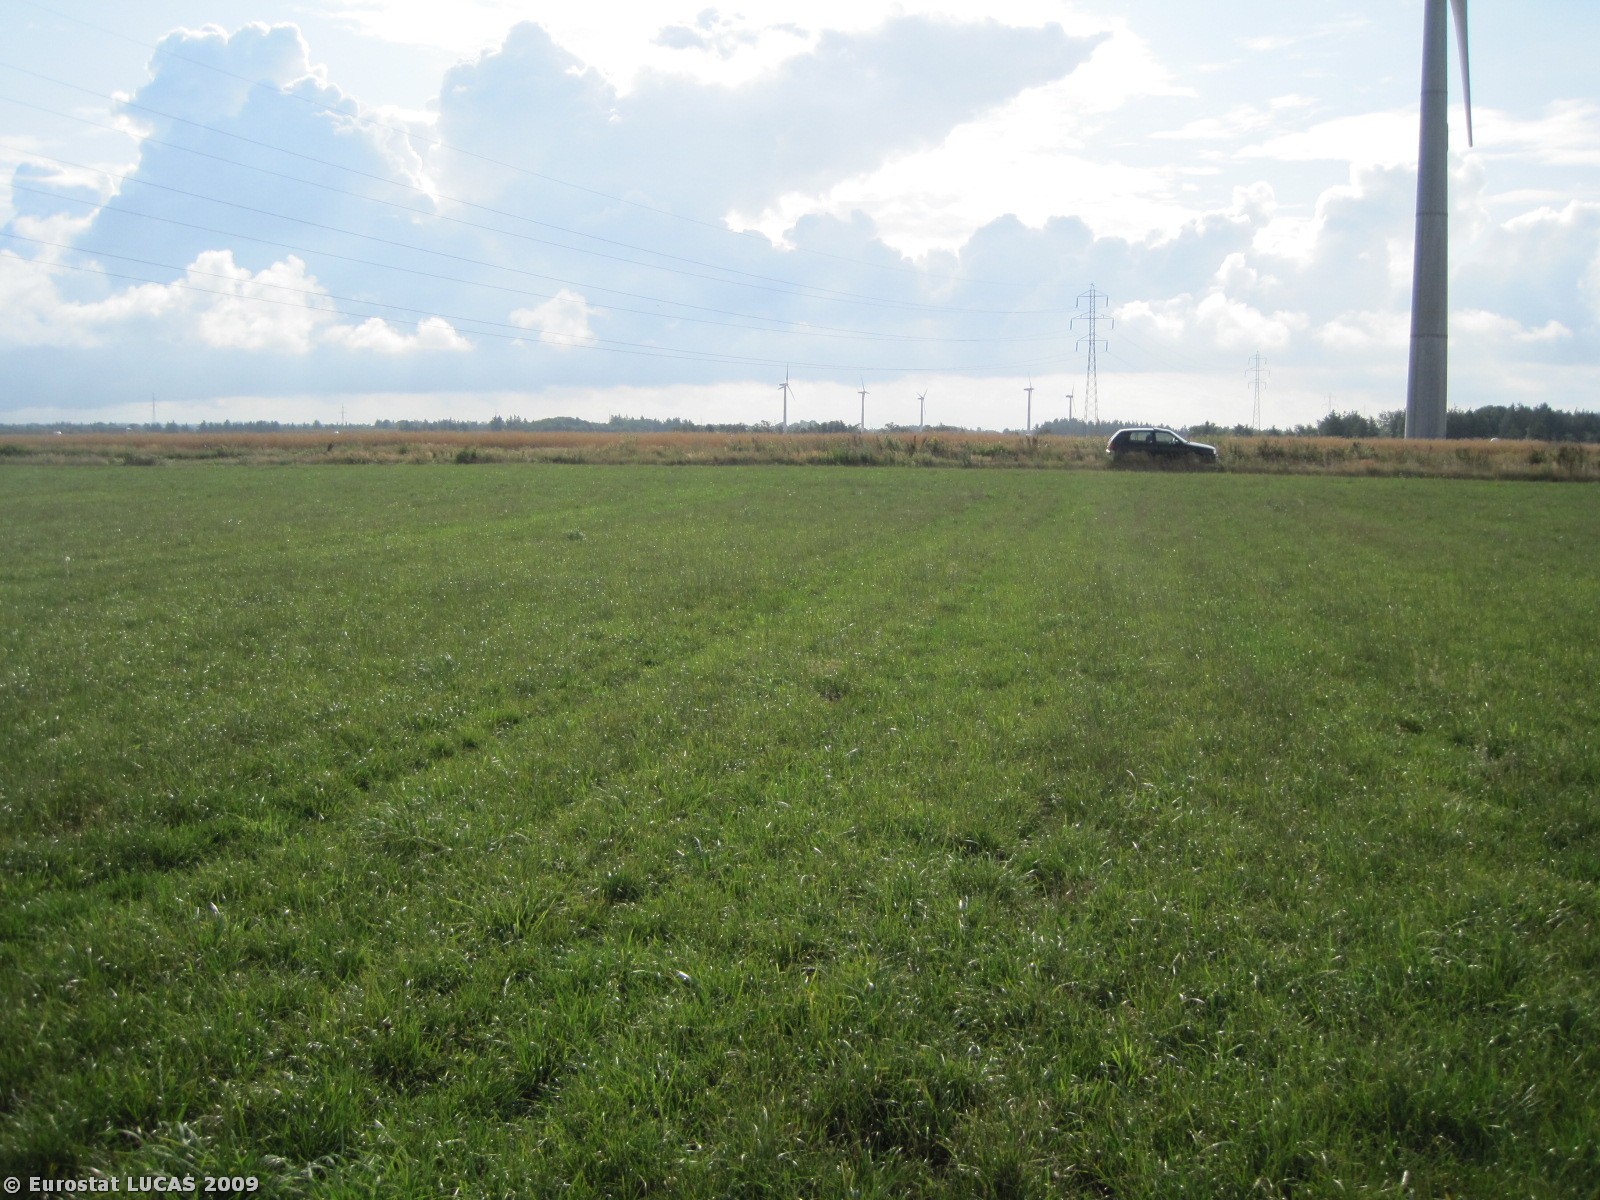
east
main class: Grassland
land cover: Grassland without tree/shrub cover
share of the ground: > 75 %
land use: Agriculture (excluding fallow land and kitchen gardens)
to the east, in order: Grassland without tree/shrub cover; Grass margins; Tracks; Grassland without tree/shrub cover; Inland water bodies; Grassland without tree/shrub cover; Common wheat; Electric lines; Common wheat
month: July
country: DK
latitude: 57.0480
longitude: 9.1606
